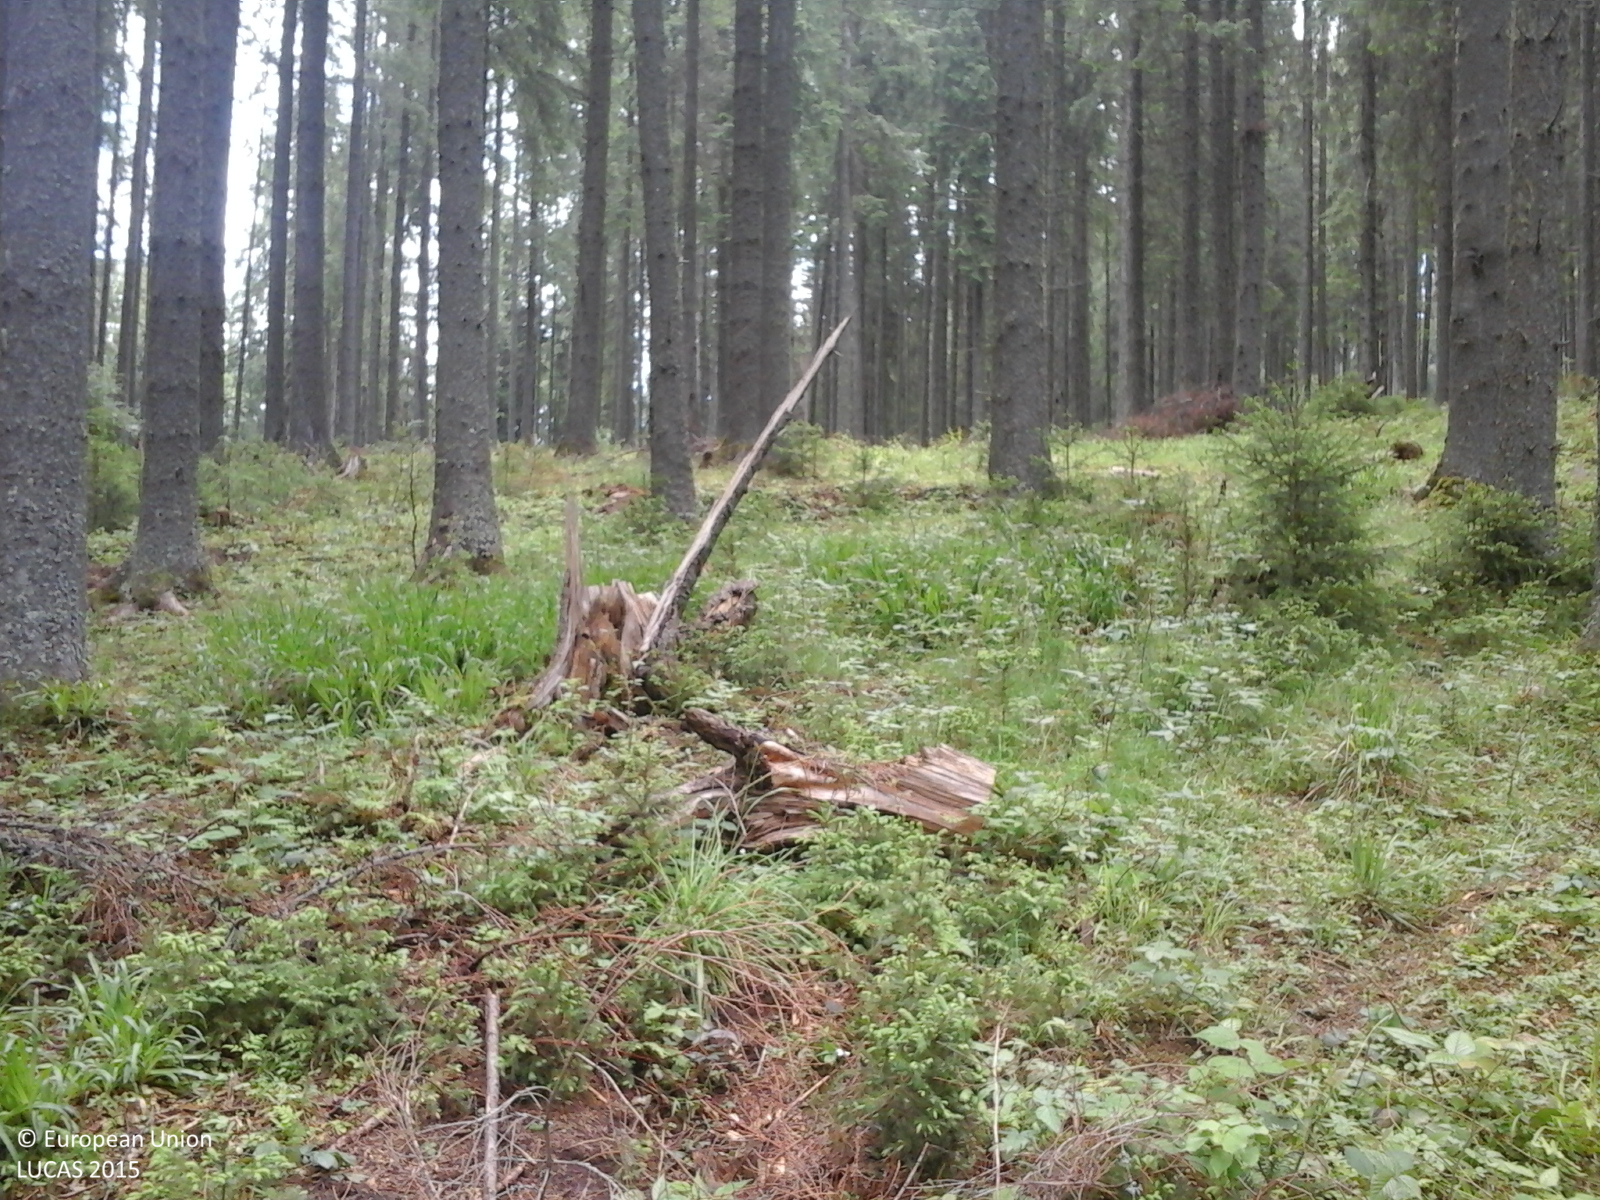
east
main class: Woodland
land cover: Spruce dominated coniferous woodland
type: alpine coniferous forest
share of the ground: > 75 %
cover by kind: coniferous forest trees 100 %
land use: Forestry
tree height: > 5 m
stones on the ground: < 10 %
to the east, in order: Spruce dominated coniferous woodland
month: June
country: RO
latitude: 47.4069
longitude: 25.1480
